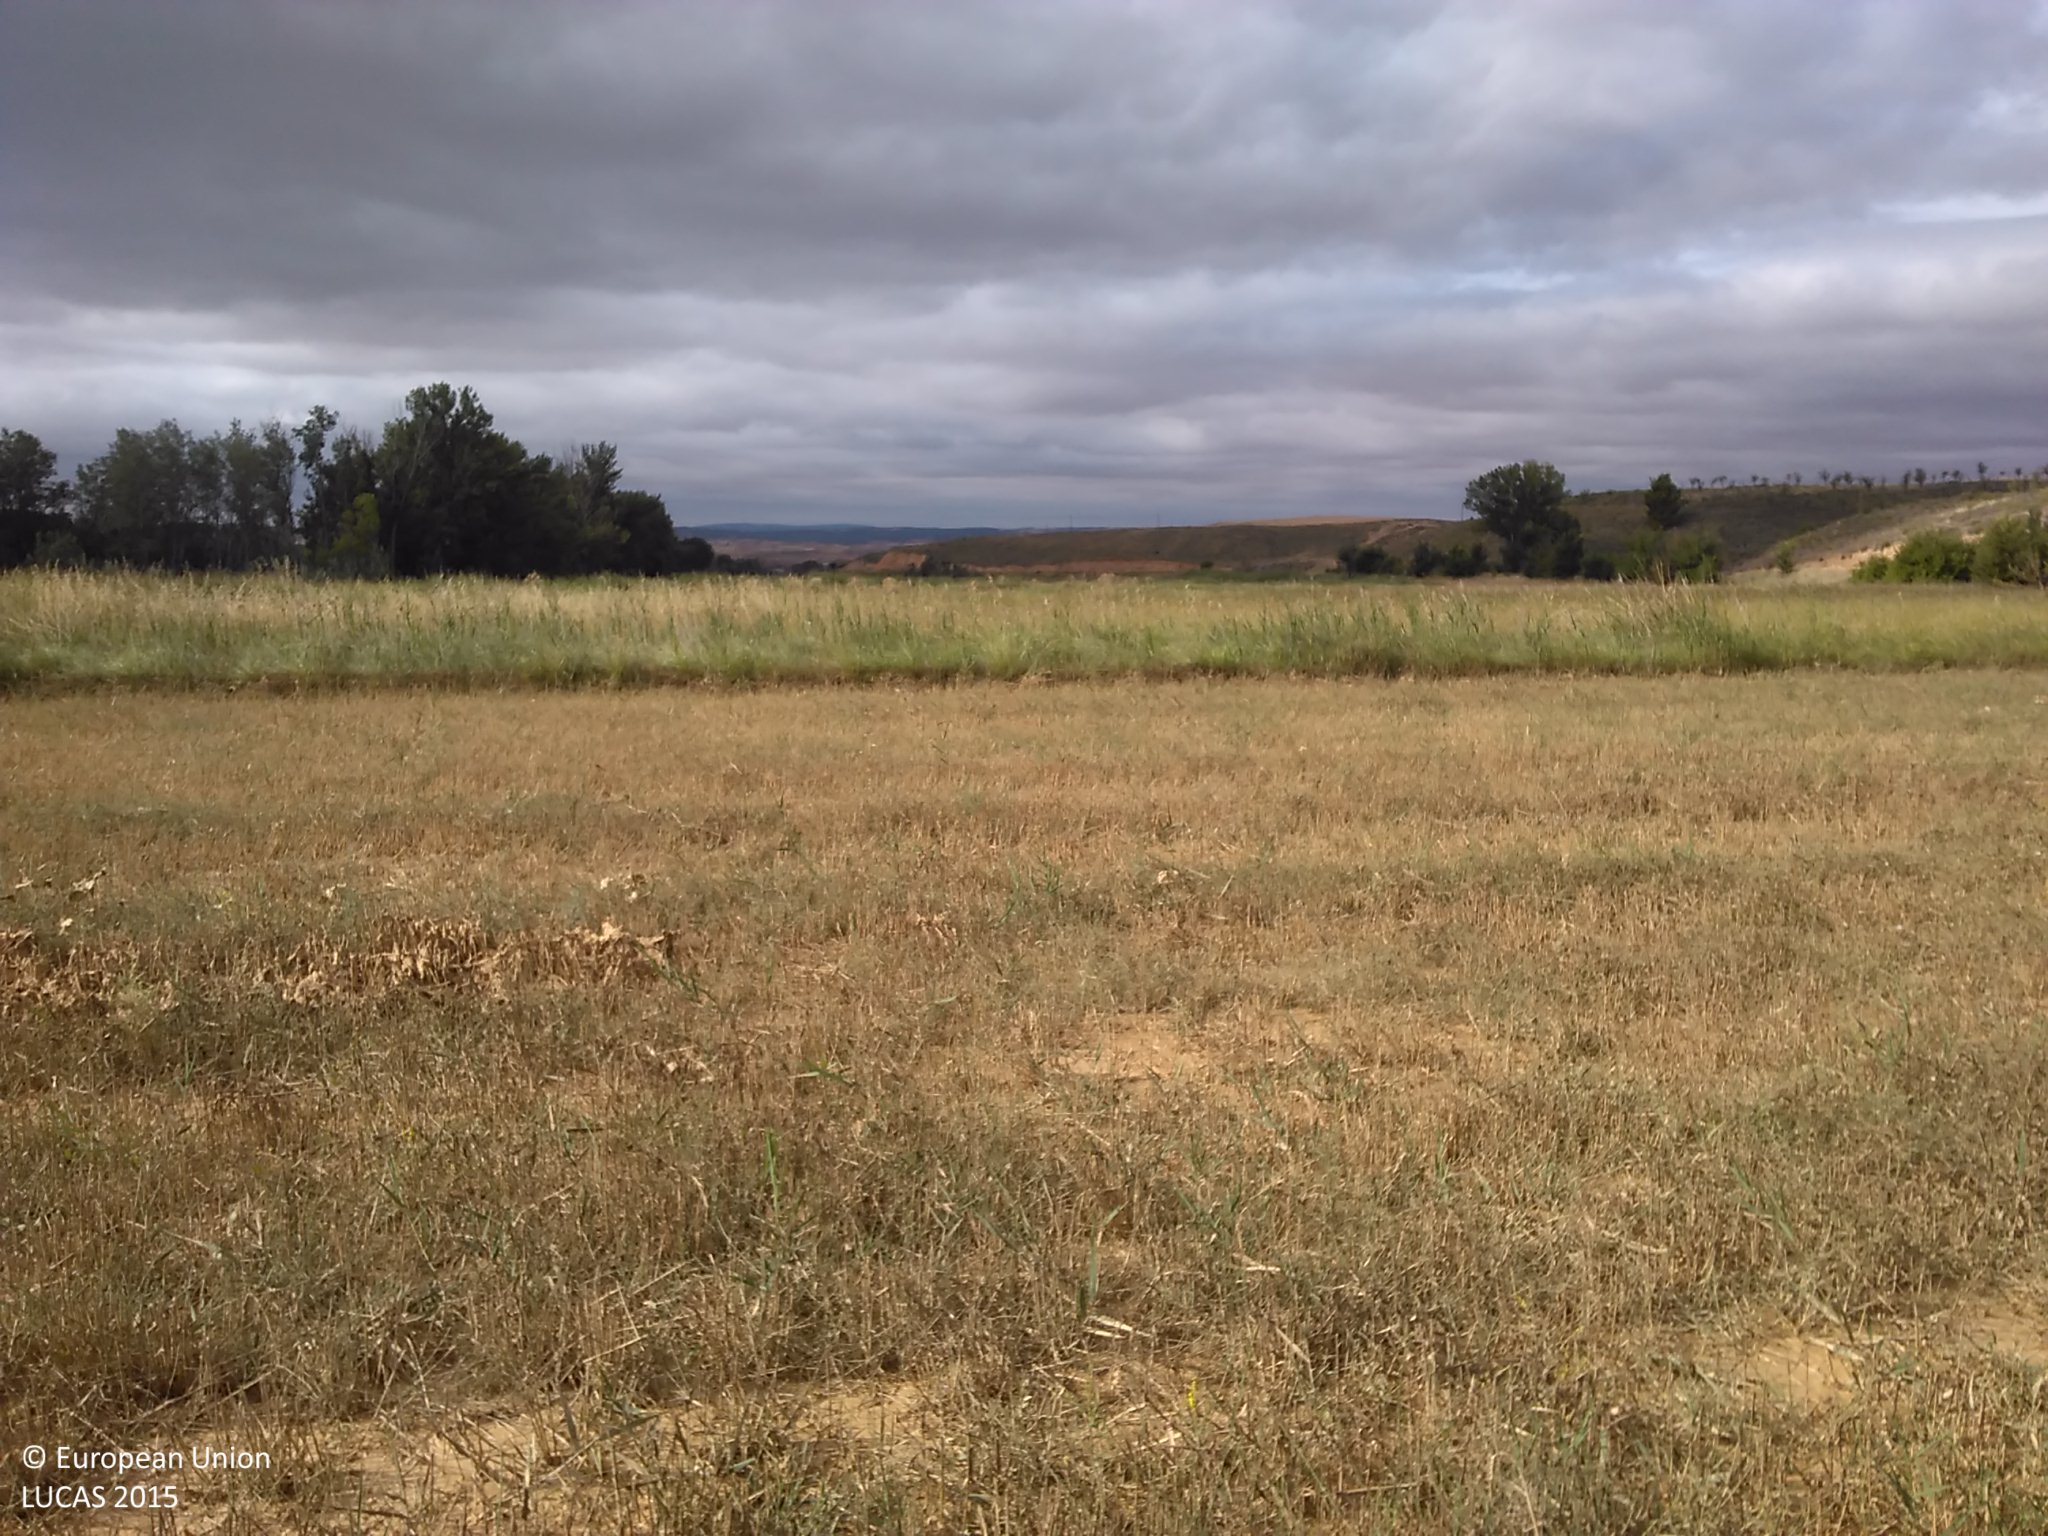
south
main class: Cropland
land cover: Barley
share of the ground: < 10 %
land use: Agriculture (excluding fallow land and kitchen gardens)
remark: Harvested field
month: July
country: ES
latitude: 41.3399
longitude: -1.9663
